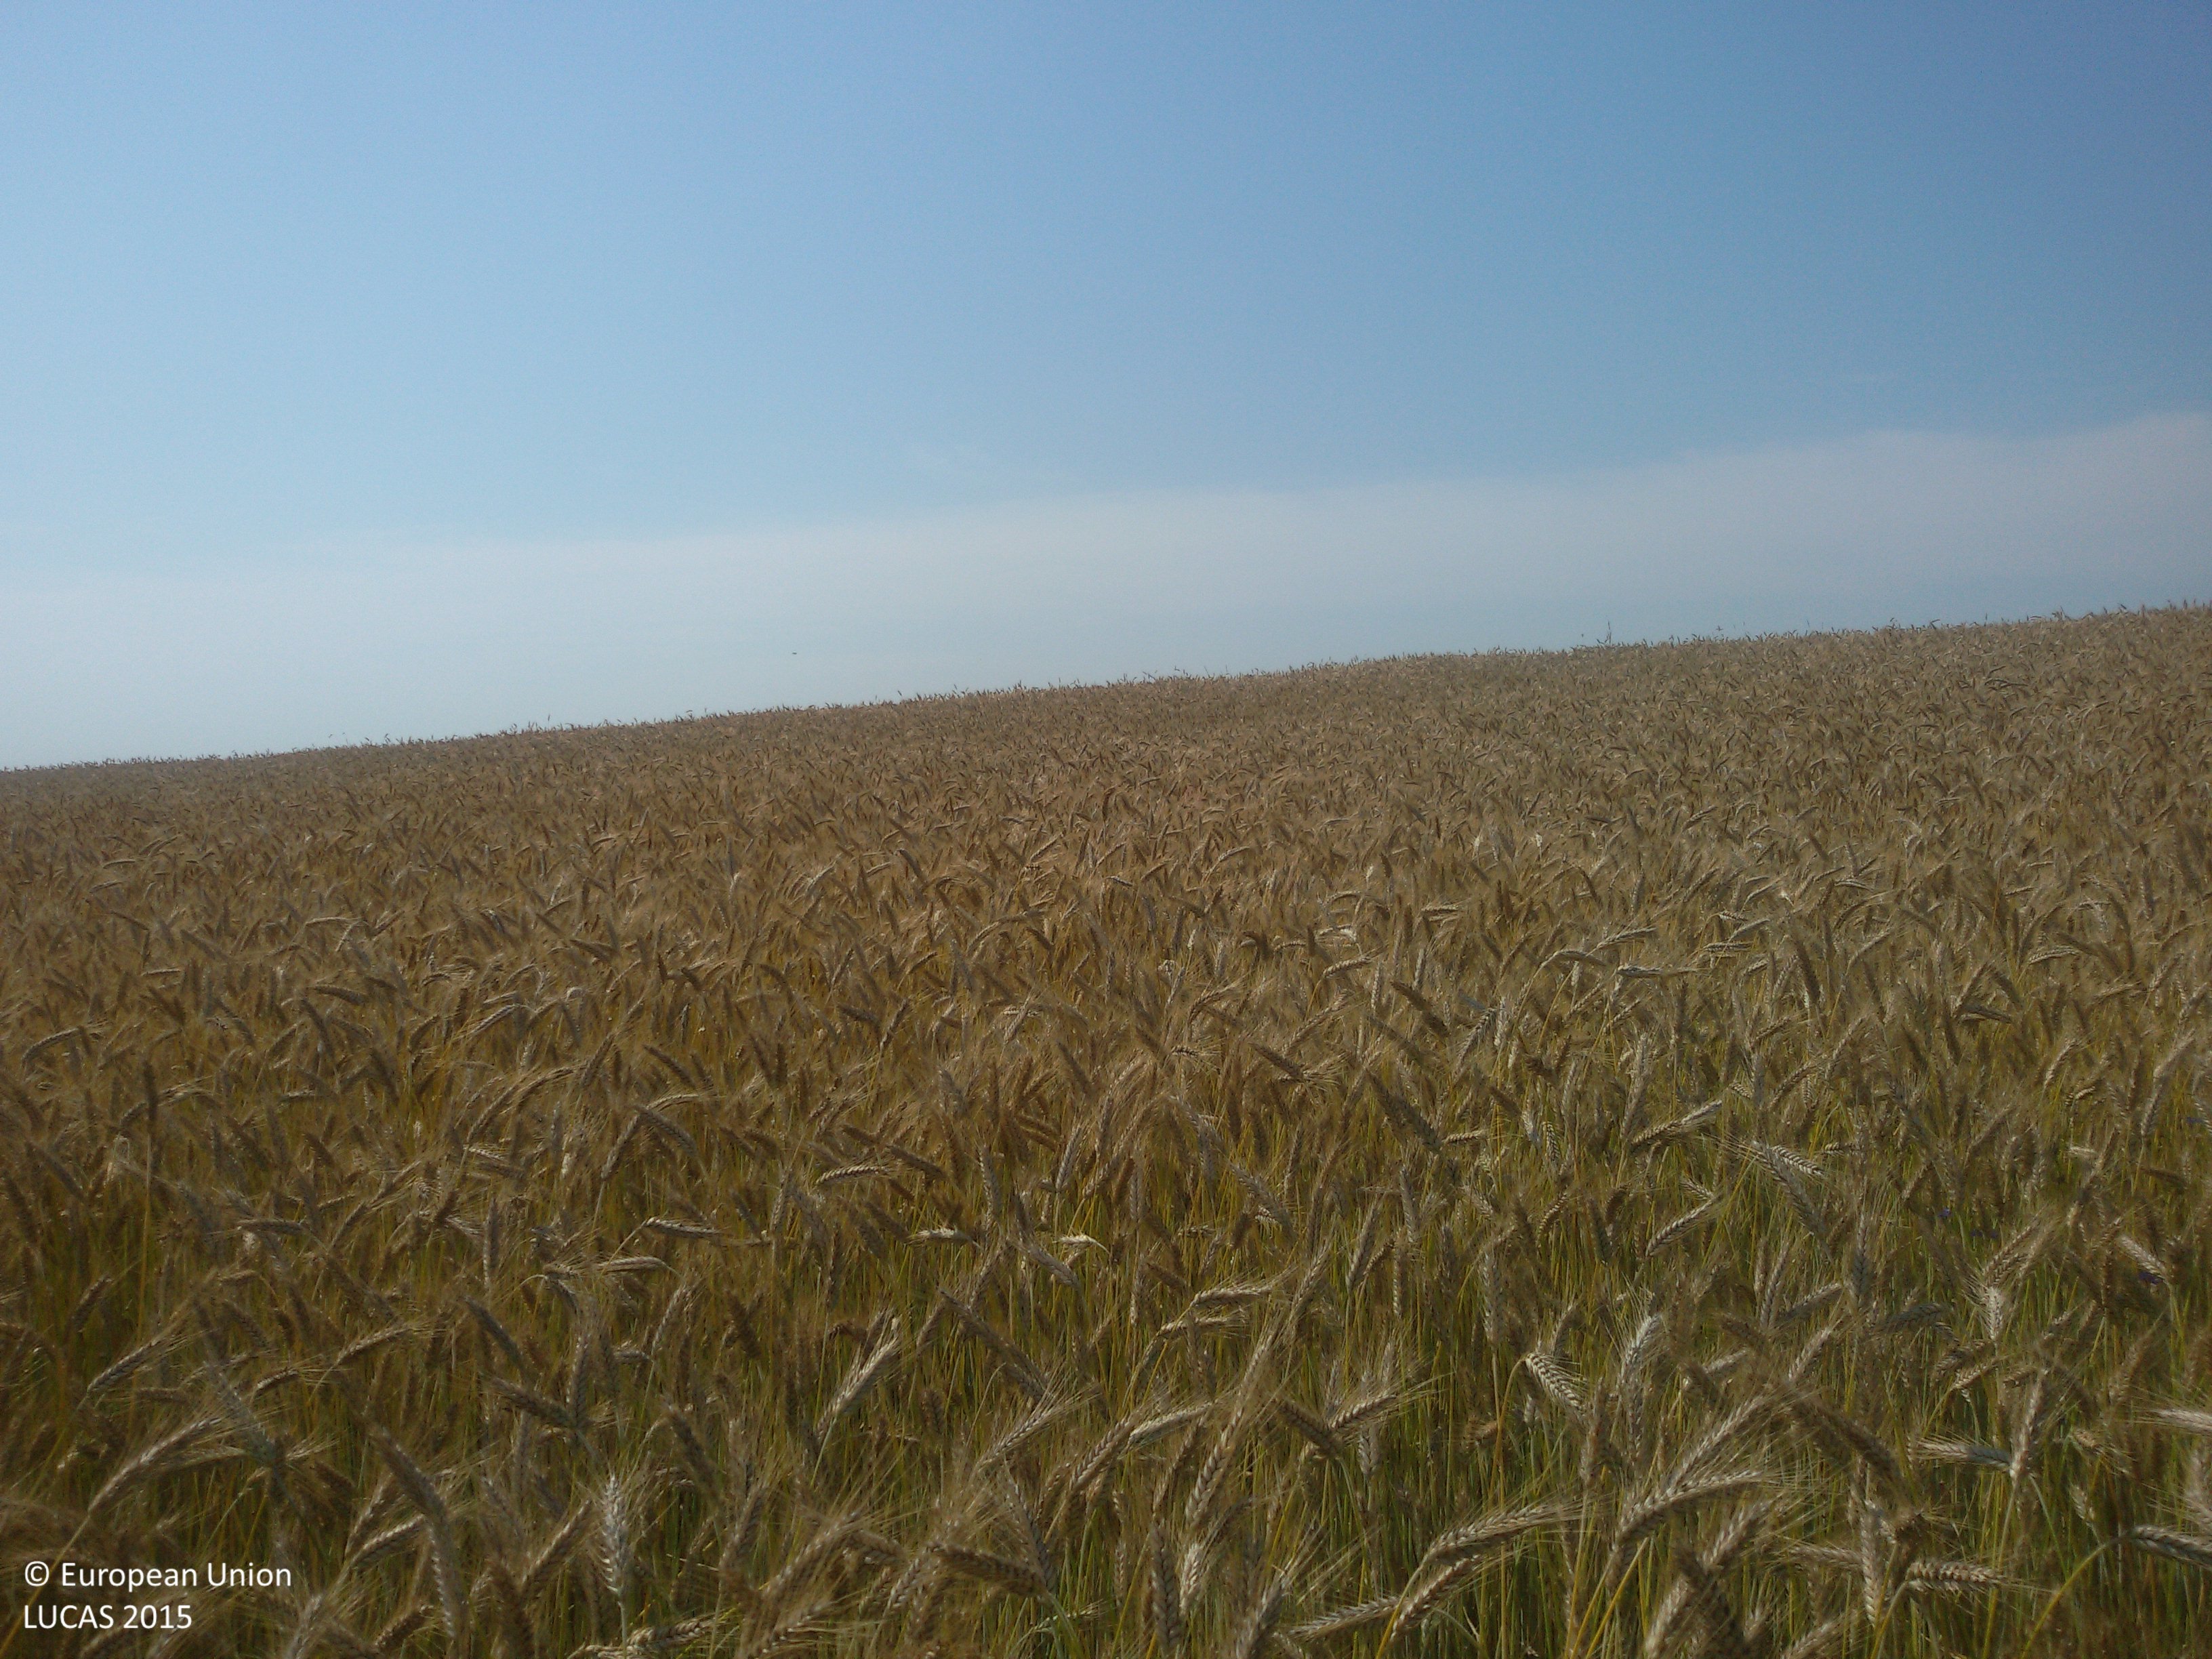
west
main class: Cropland
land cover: Triticale
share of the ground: > 75 %
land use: Agriculture (excluding fallow land and kitchen gardens)
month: July
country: PL
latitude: 53.3361
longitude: 17.7172
